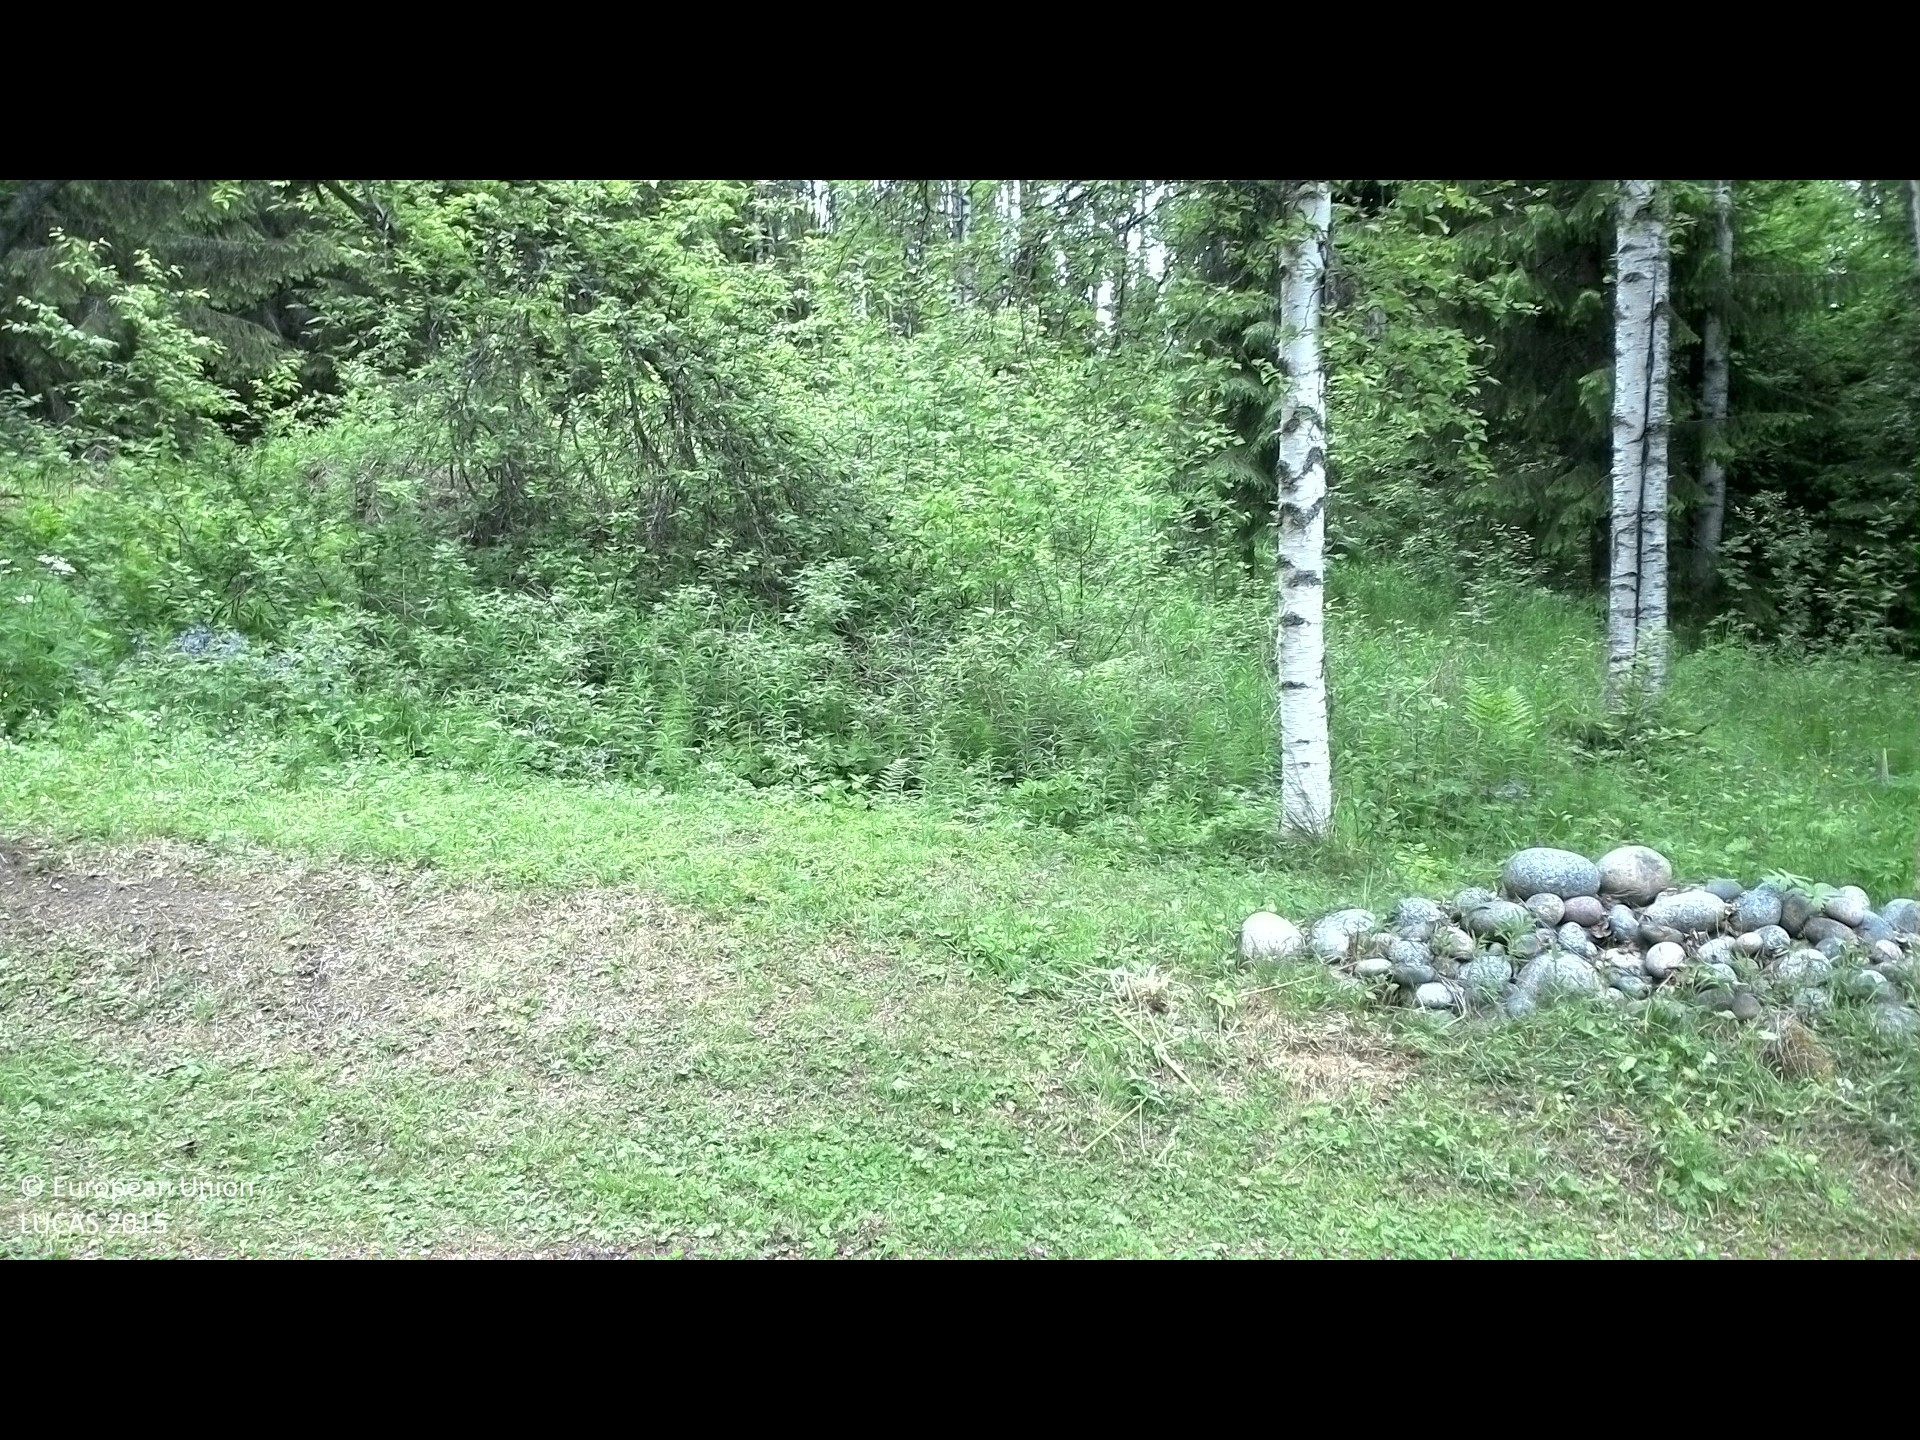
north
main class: Grassland
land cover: Grassland without tree/shrub cover
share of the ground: > 75 %
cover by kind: herbaceous plants 100 %
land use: Residential
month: June
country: SE
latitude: 62.0426
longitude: 16.3868
